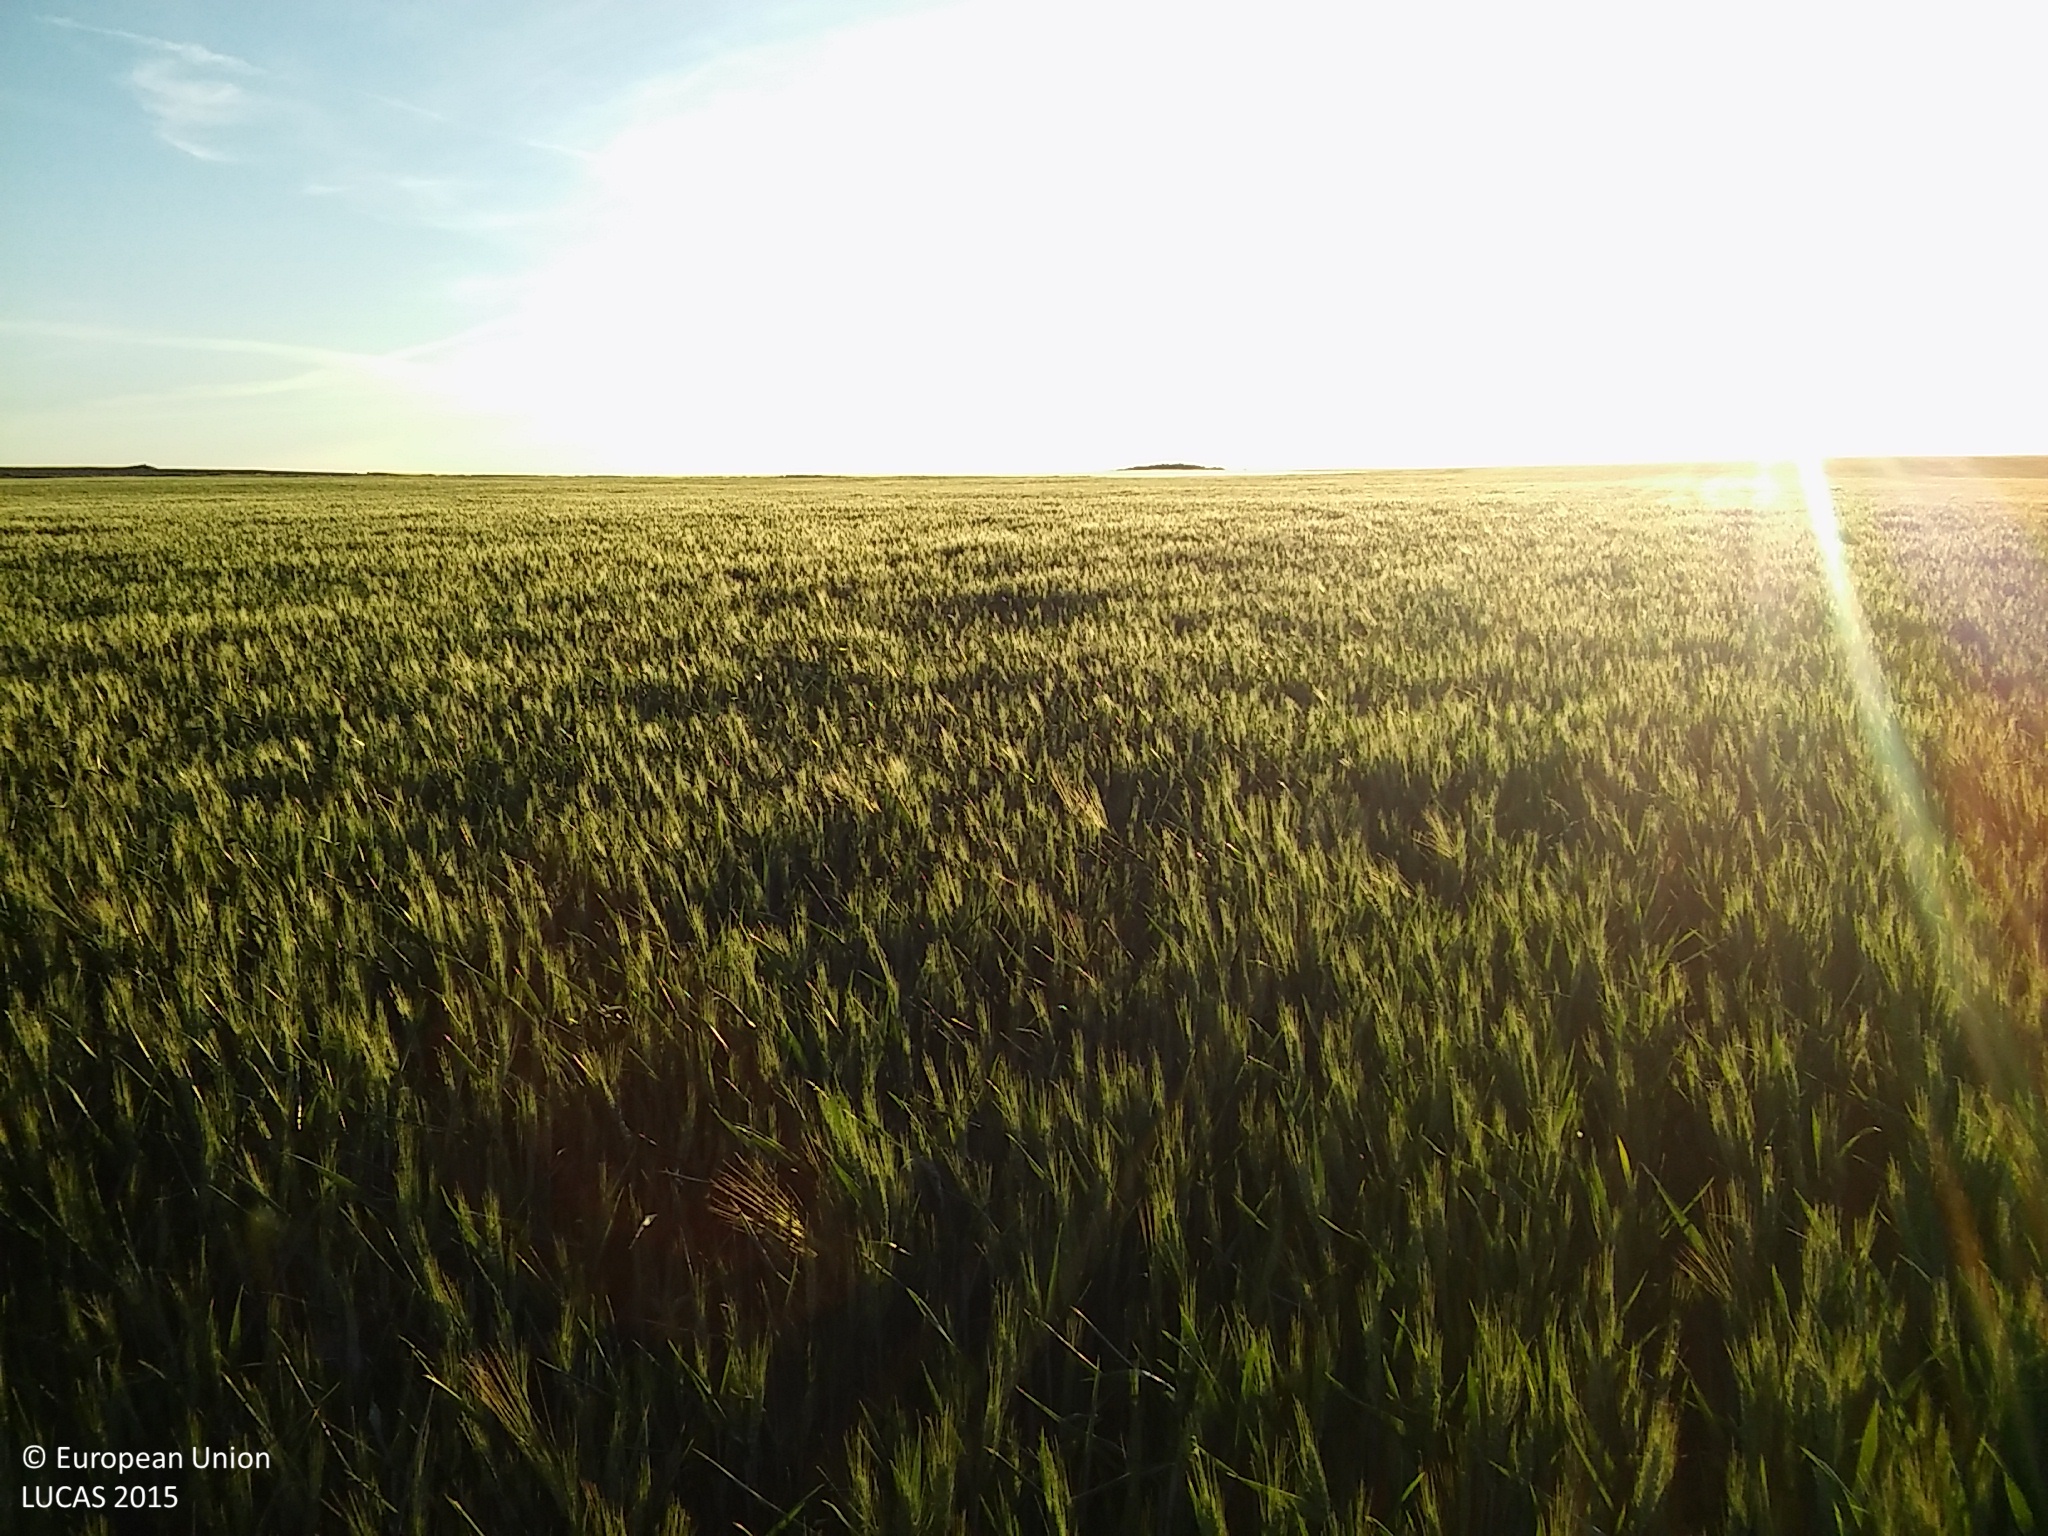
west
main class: Cropland
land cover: Common wheat
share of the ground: > 75 %
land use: Agriculture (excluding fallow land and kitchen gardens)
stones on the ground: 25 - 50 %
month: May
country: ES
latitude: 41.3998
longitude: -4.0129
